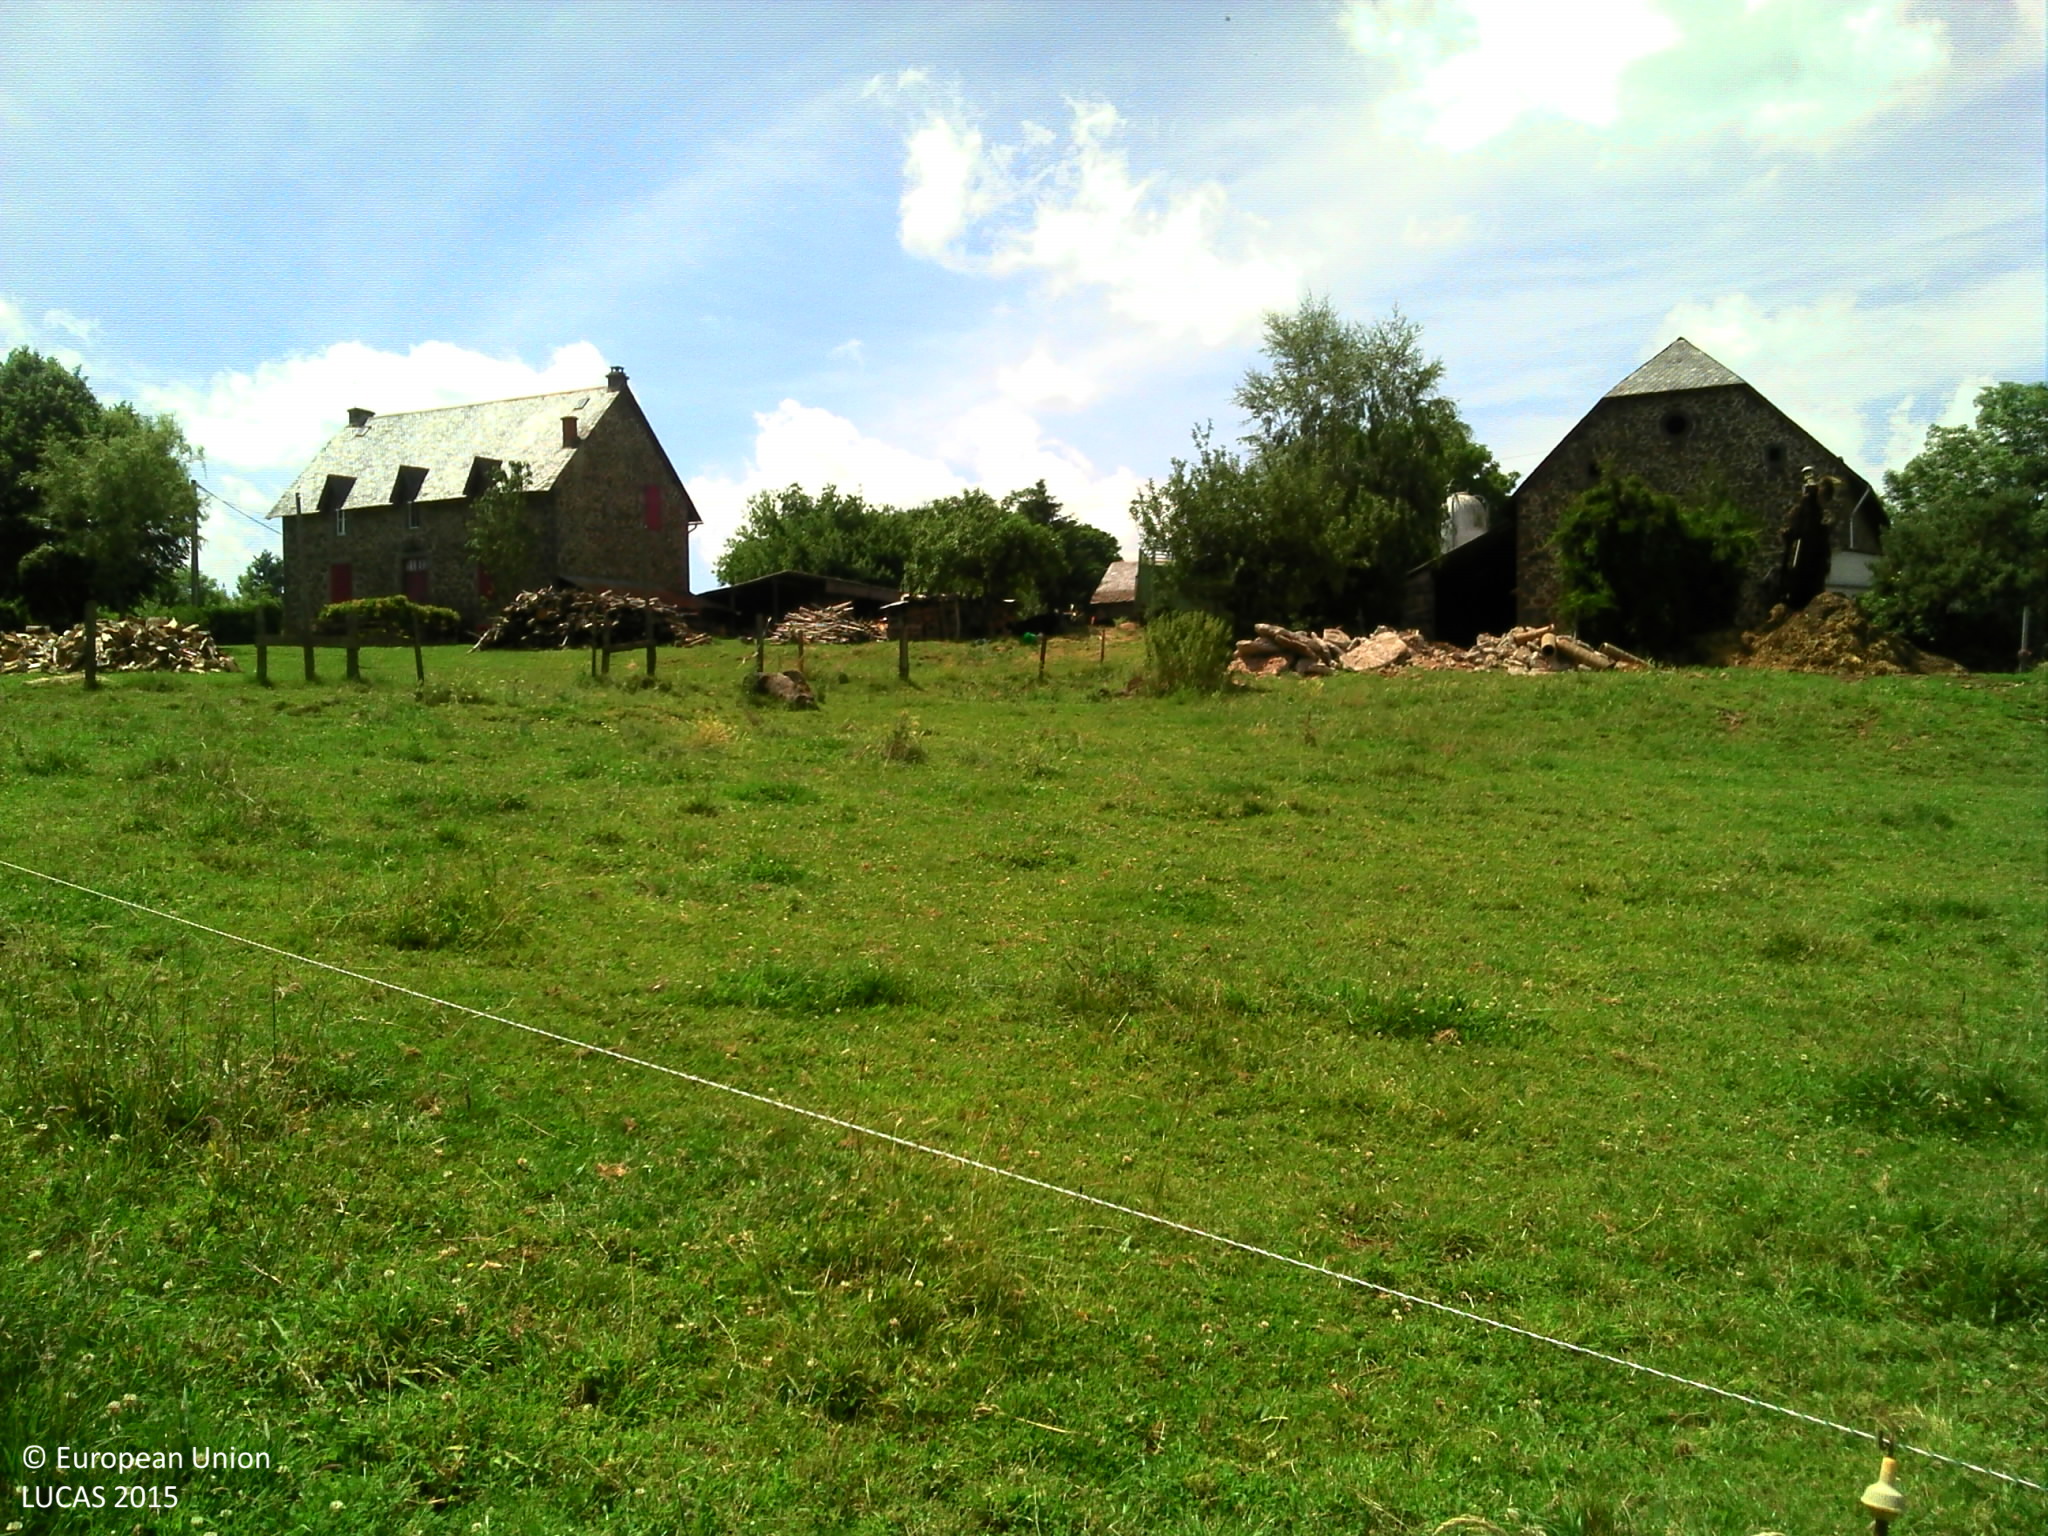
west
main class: Grassland
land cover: Grassland without tree/shrub cover
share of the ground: > 75 %
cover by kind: herbaceous plants 100 %
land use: Agriculture (excluding fallow land and kitchen gardens)
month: June
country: FR
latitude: 45.2262
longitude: 2.3445
